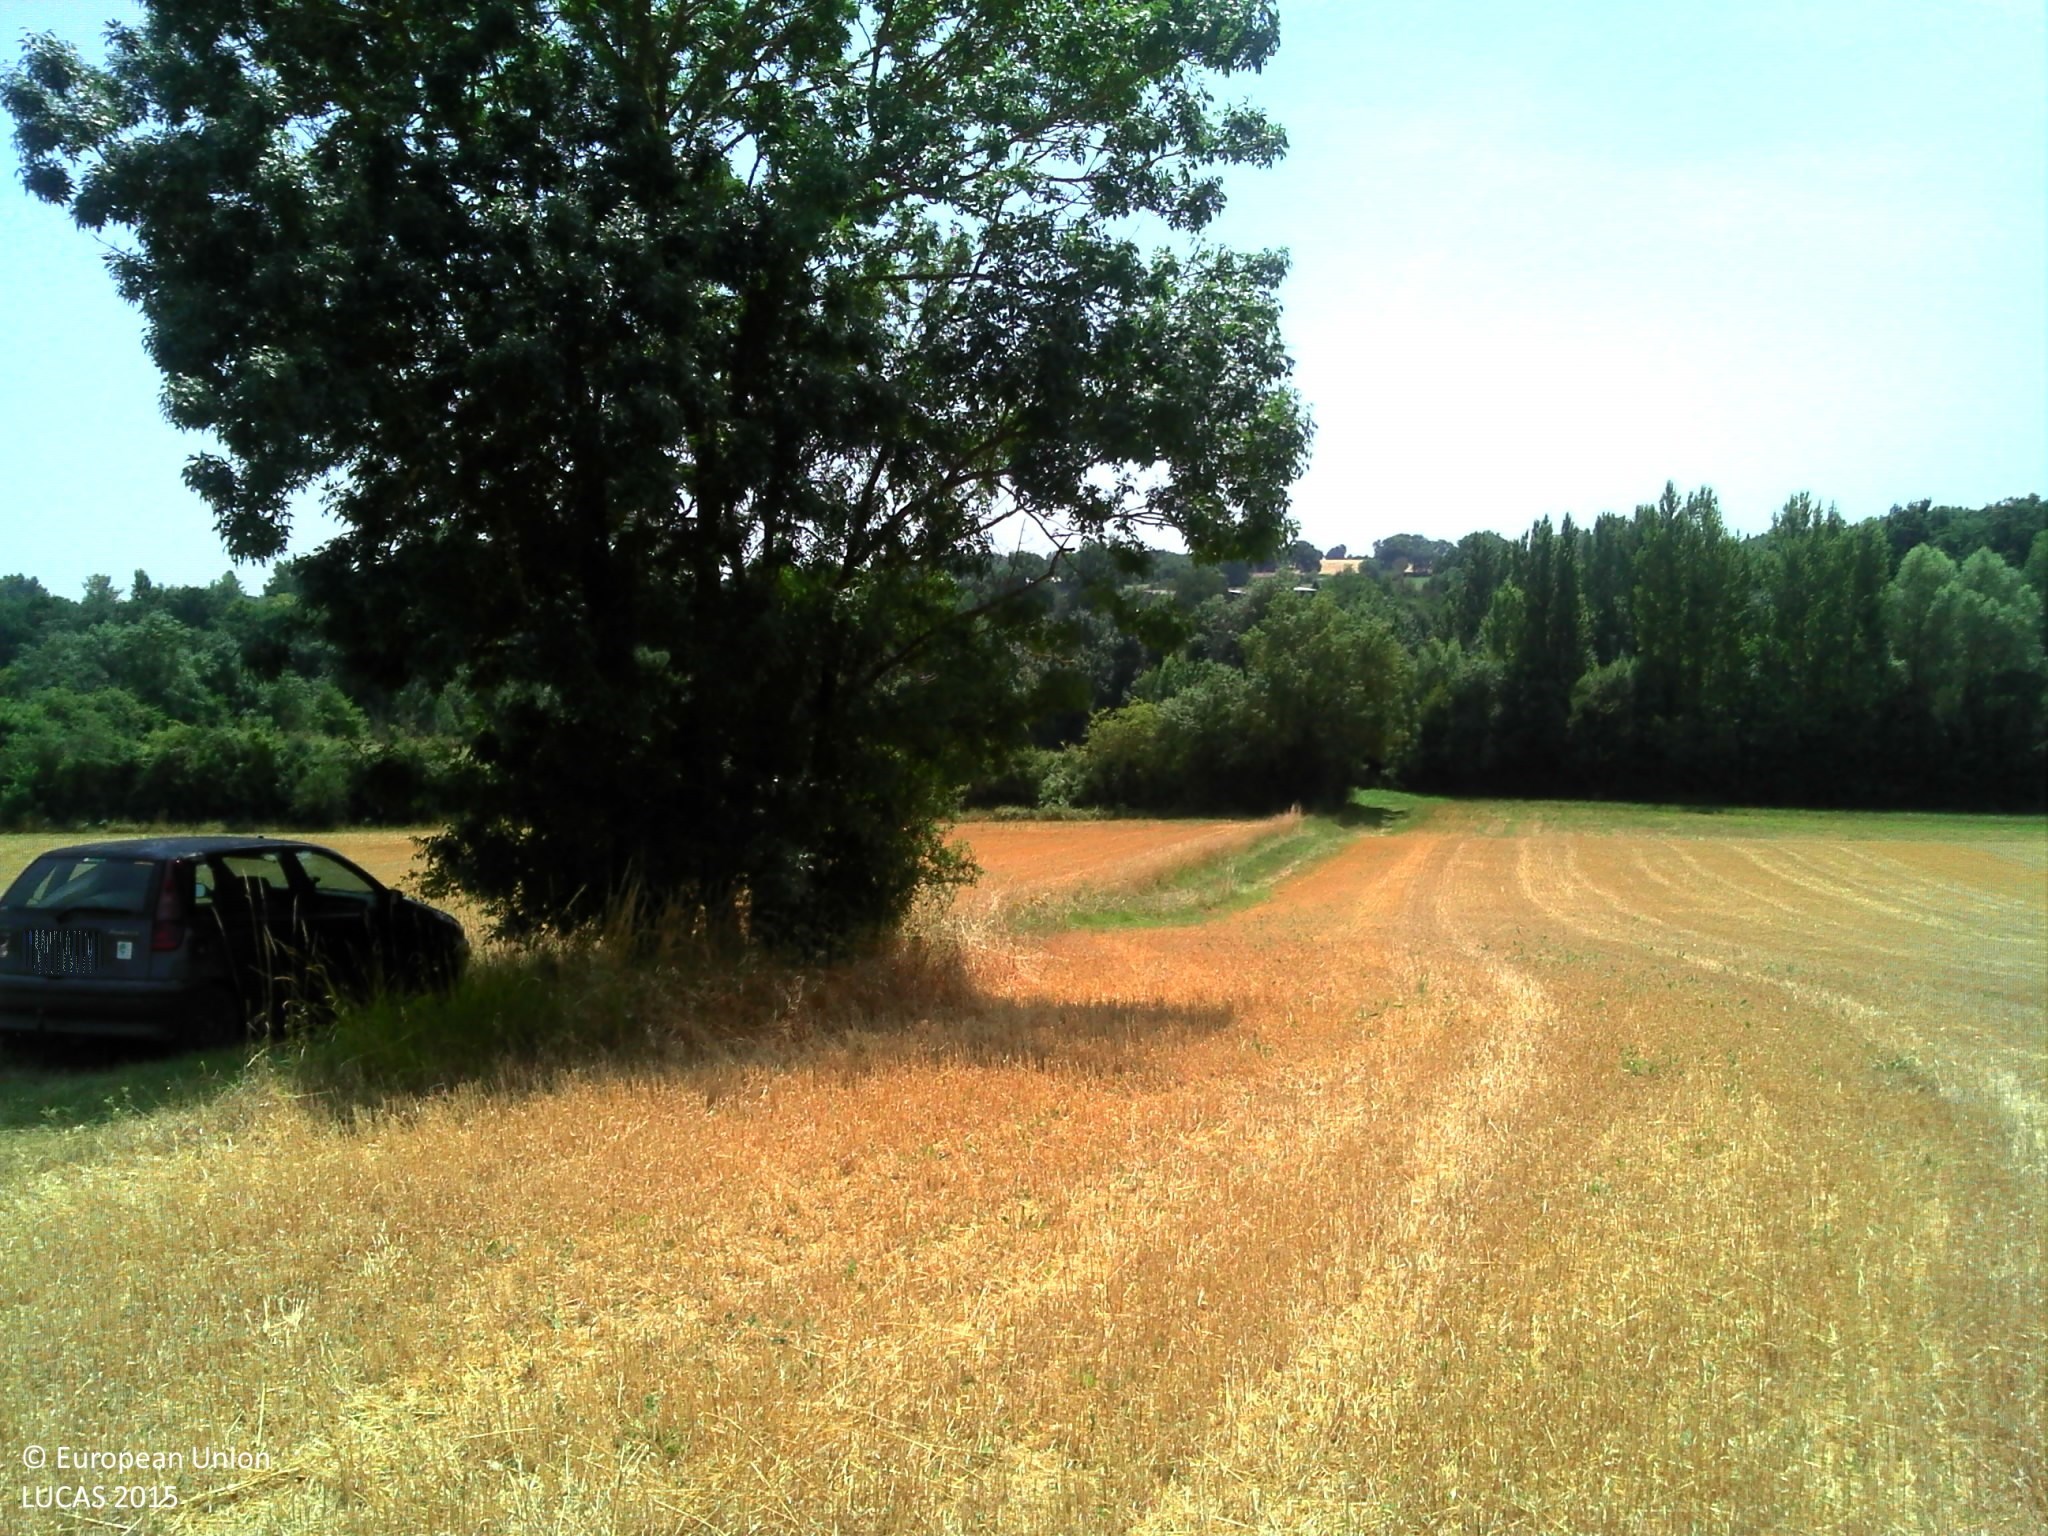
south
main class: Cropland
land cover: Barley
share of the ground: > 75 %
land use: Agriculture (excluding fallow land and kitchen gardens)
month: July
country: FR
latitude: 43.6492
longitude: 0.9866
